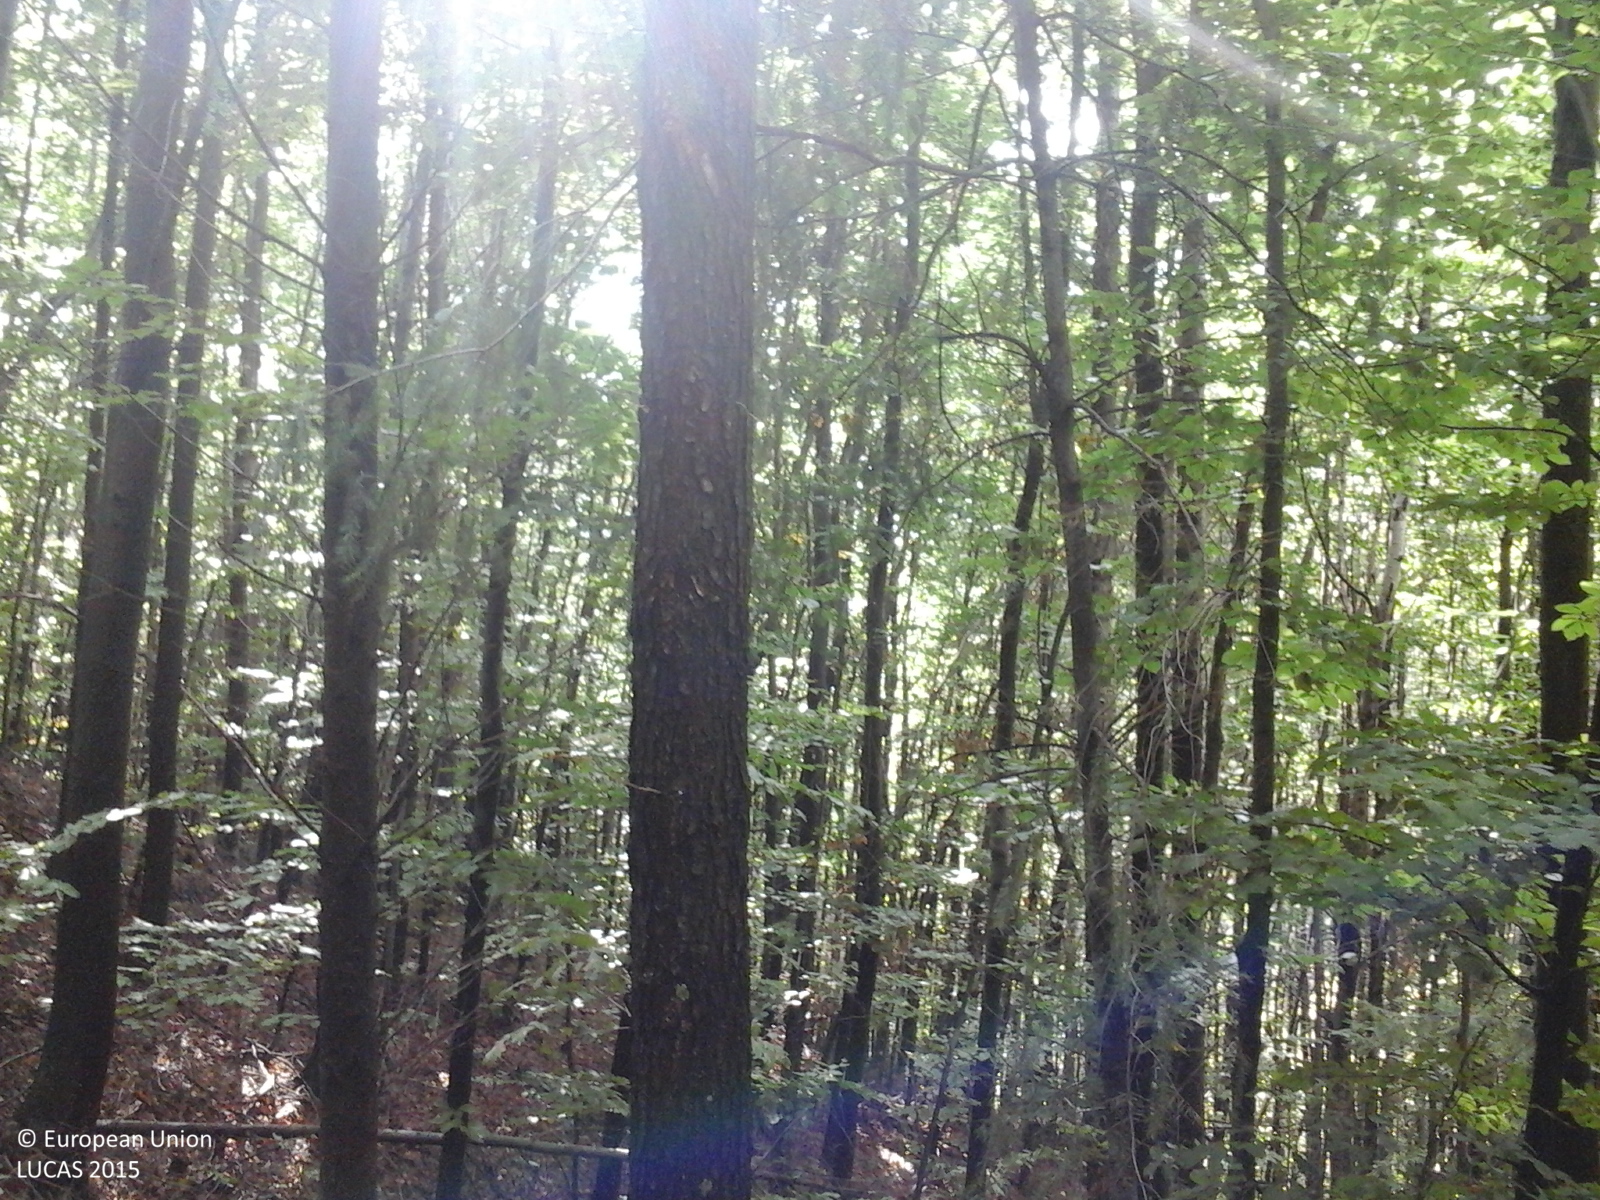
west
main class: Woodland
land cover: Other mixed woodland
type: beech forest
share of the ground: > 75 %
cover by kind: broadleaved forest trees 75 %, coniferous forest trees 25 %
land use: Forestry
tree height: > 5 m
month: September
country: RO
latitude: 45.1958
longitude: 24.4733
